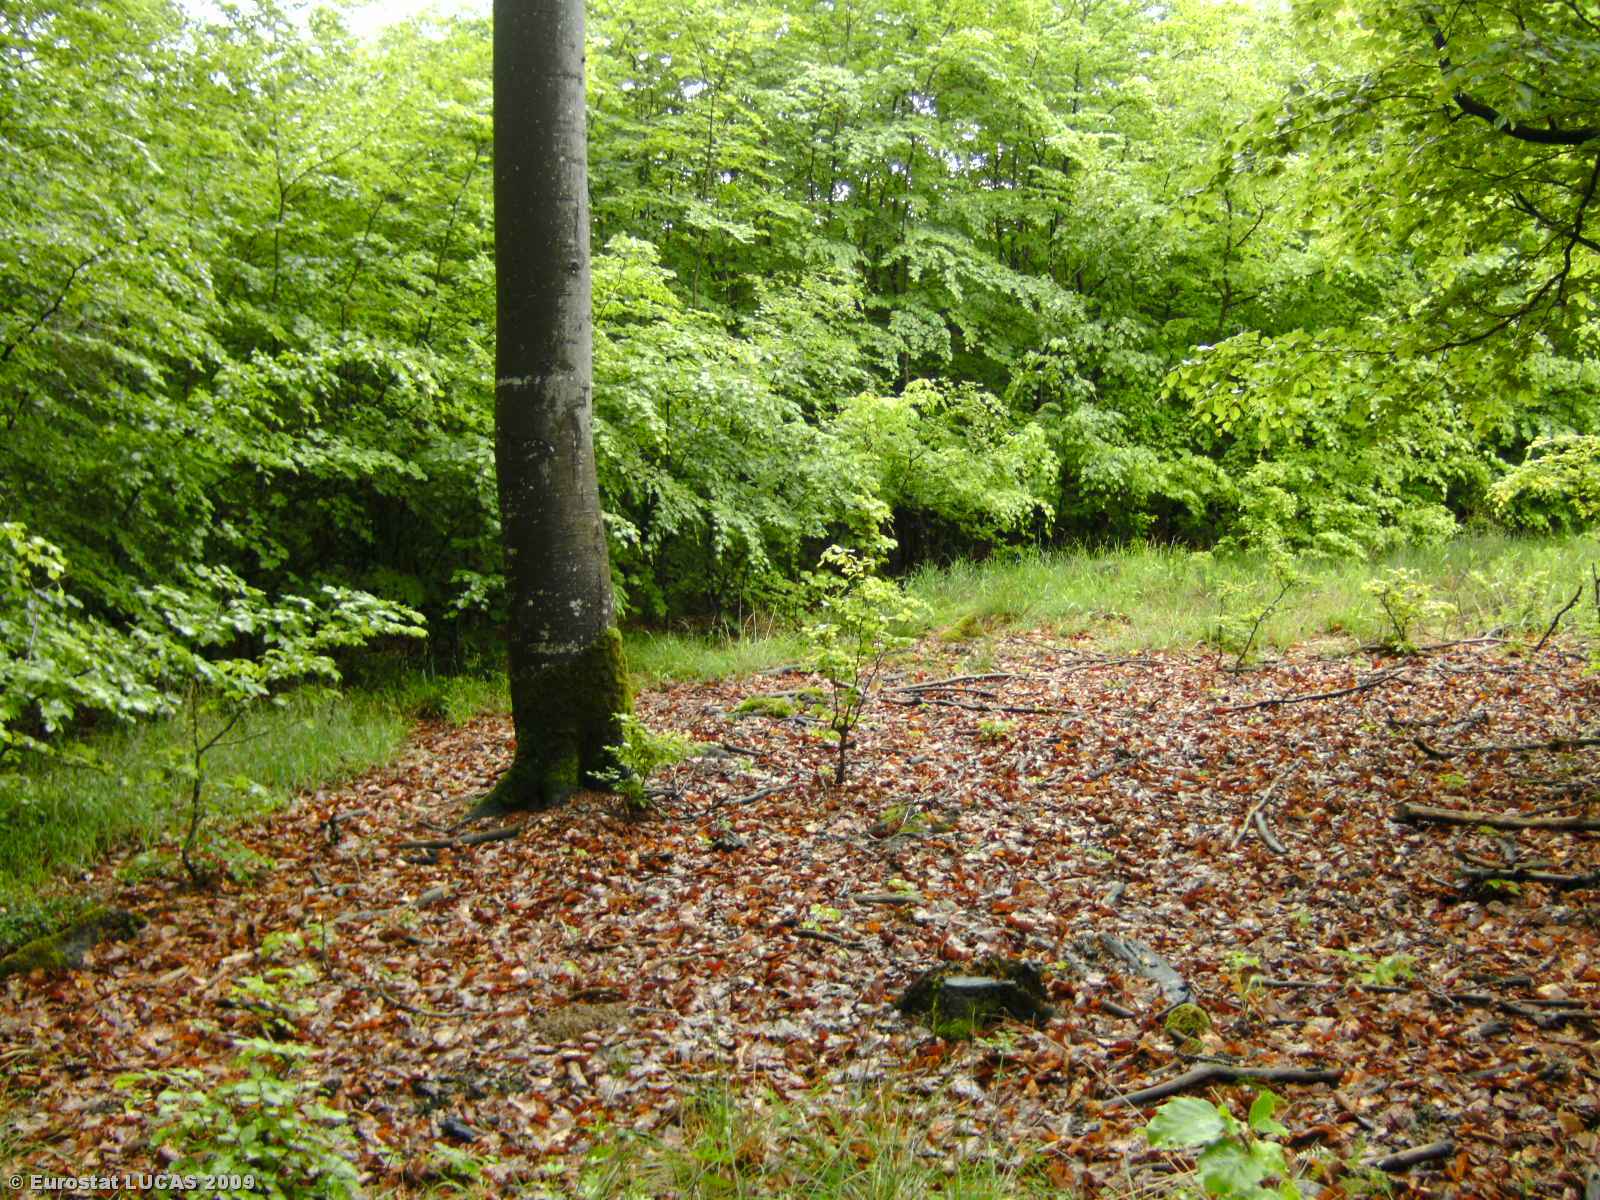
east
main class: Woodland
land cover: Broadleaved woodland
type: beech forest
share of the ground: 50 - 75 %
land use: Forestry
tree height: > 5 m
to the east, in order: Broadleaved woodland
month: May
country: LU
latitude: 49.8178
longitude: 6.2886
